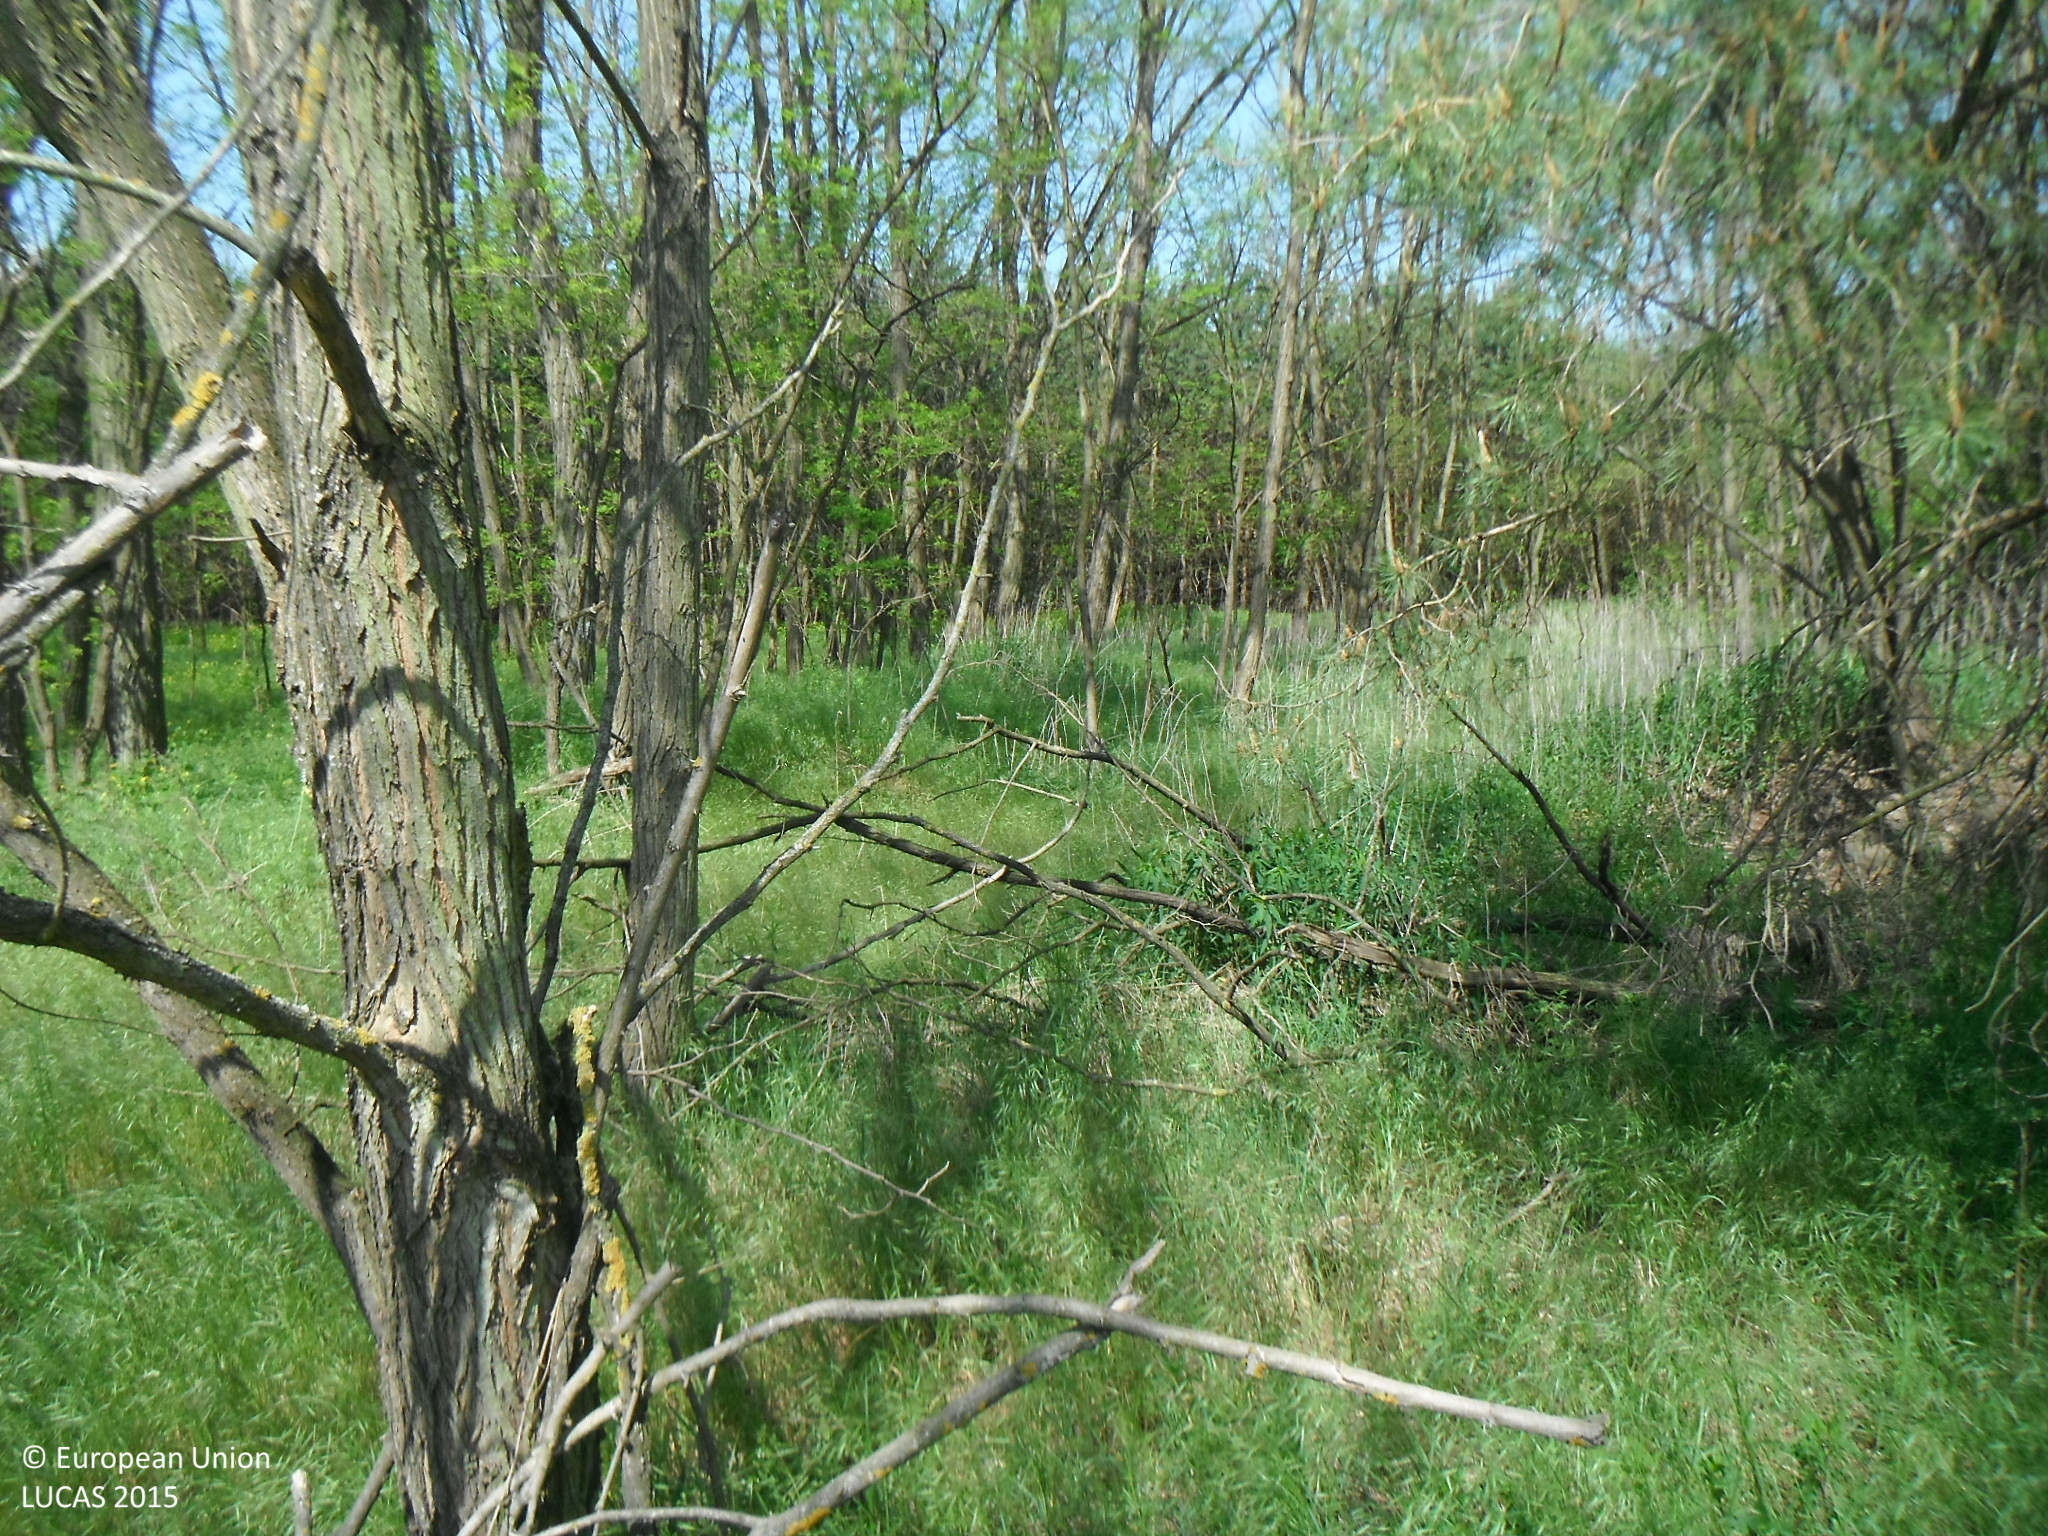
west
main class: Woodland
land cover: Broadleaved woodland
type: exotic forest
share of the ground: 50 - 75 %
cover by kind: broadleaved forest trees 60 %, herbaceous plants 35 %, shrubs 5 %
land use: Semi-natural and natural areas not in use
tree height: > 5 m
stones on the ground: < 10 %
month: May
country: SK
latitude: 48.5420
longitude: 17.0110
